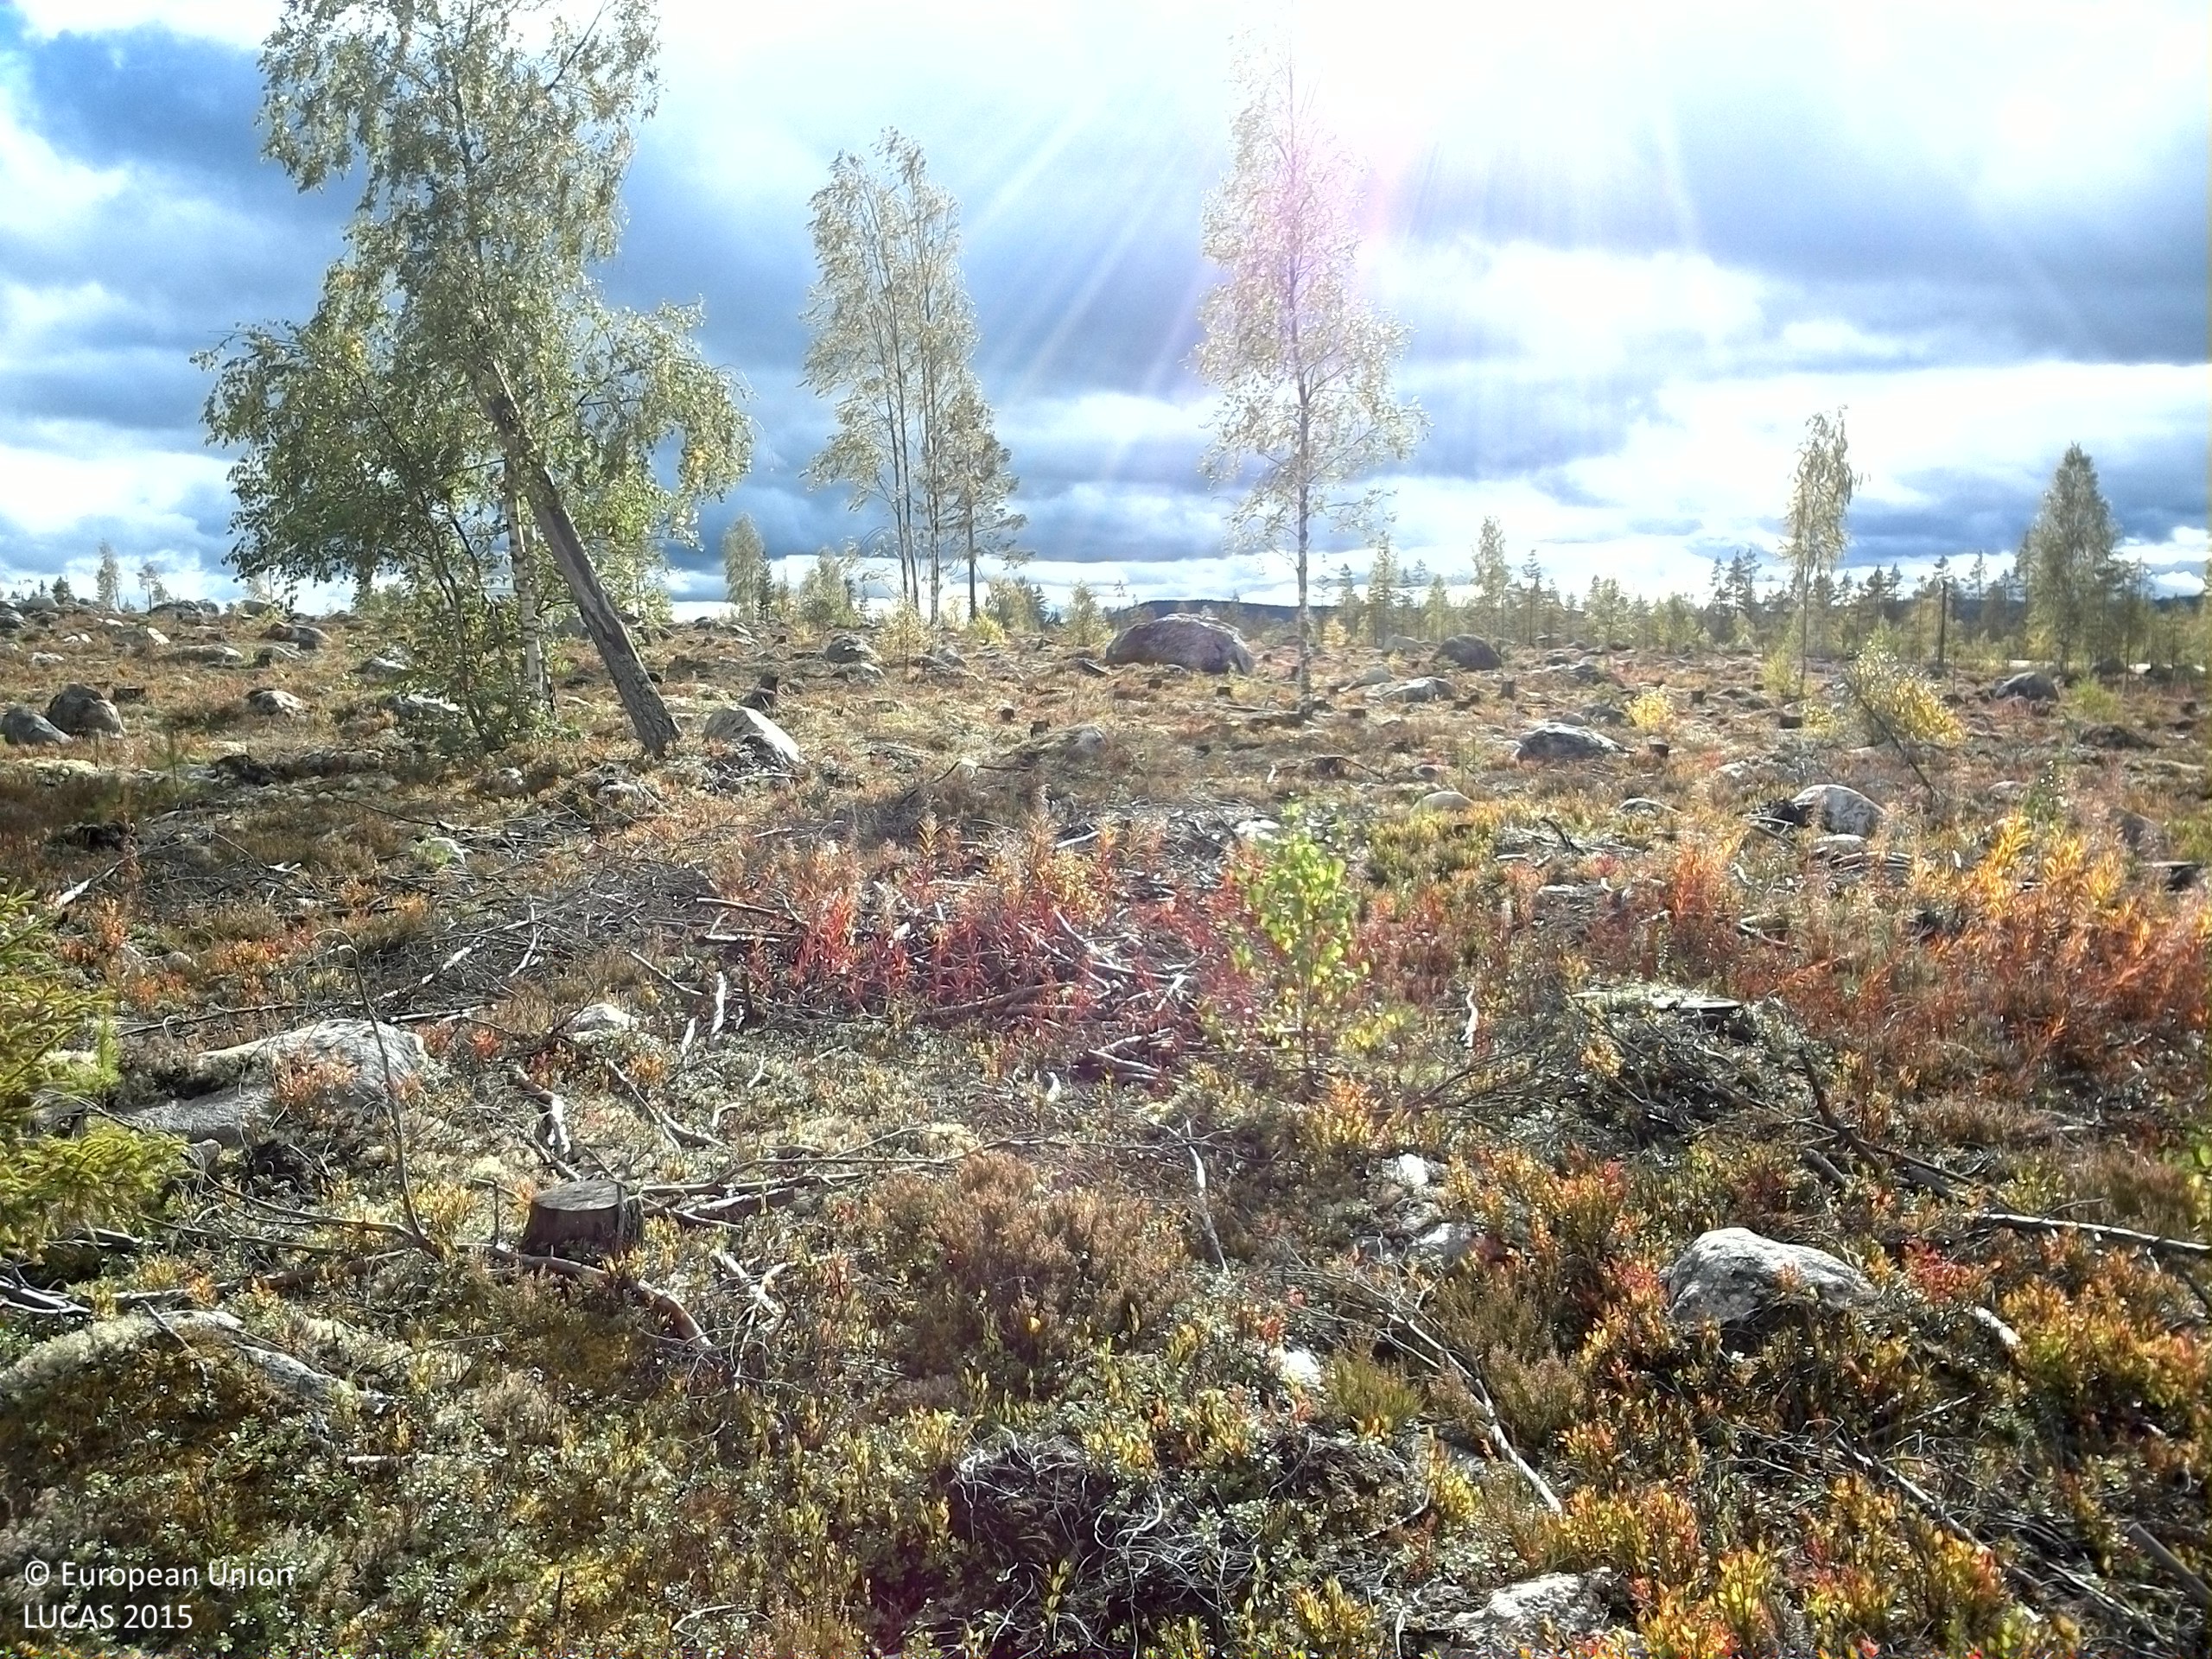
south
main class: Shrubland
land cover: Shrubland with sparse tree cover
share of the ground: > 75 %
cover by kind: shrubs 50 %, consolidated bare surface 25 %, lichens and mosses 20 %, coniferous forest trees 5 %
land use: Forestry
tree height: > 5 m
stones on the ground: 10 - 25 %
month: September
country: SE
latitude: 61.4933
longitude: 15.1870
